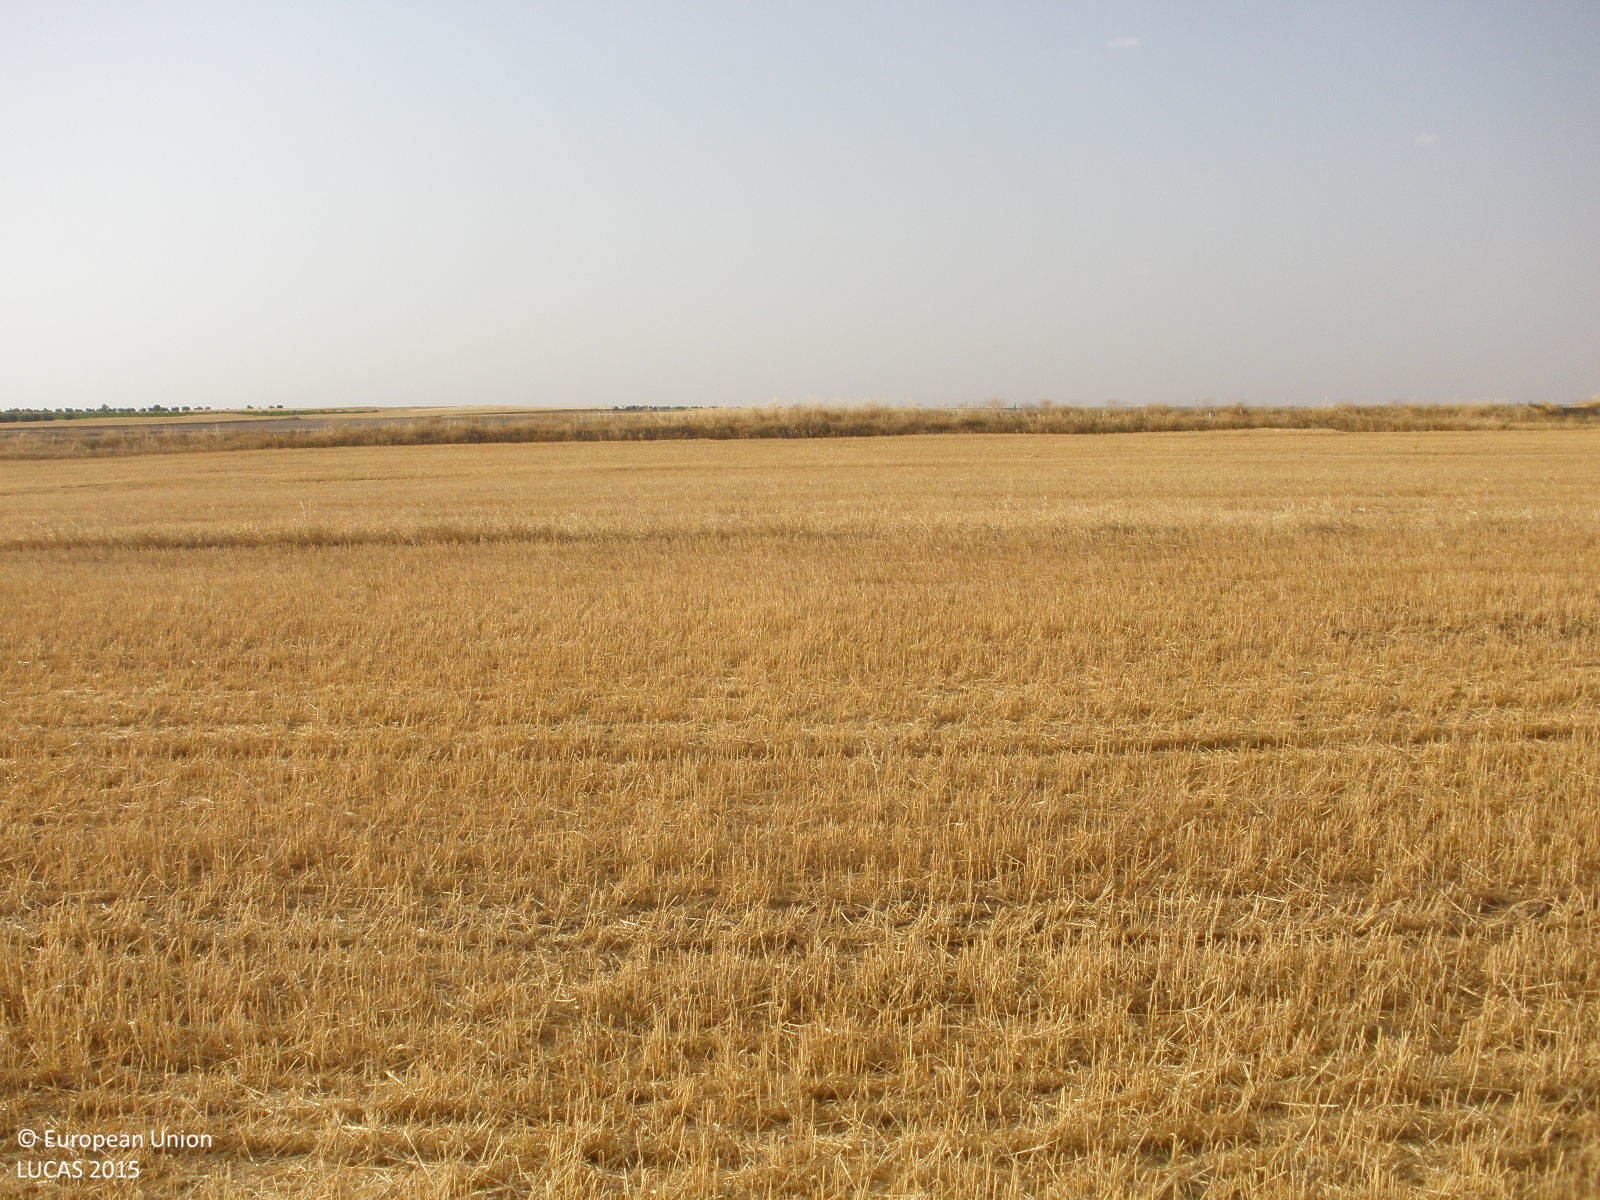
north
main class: Cropland
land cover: Common wheat
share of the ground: < 10 %
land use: Agriculture (excluding fallow land and kitchen gardens)
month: July
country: ES
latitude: 39.7157
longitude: -3.3571
